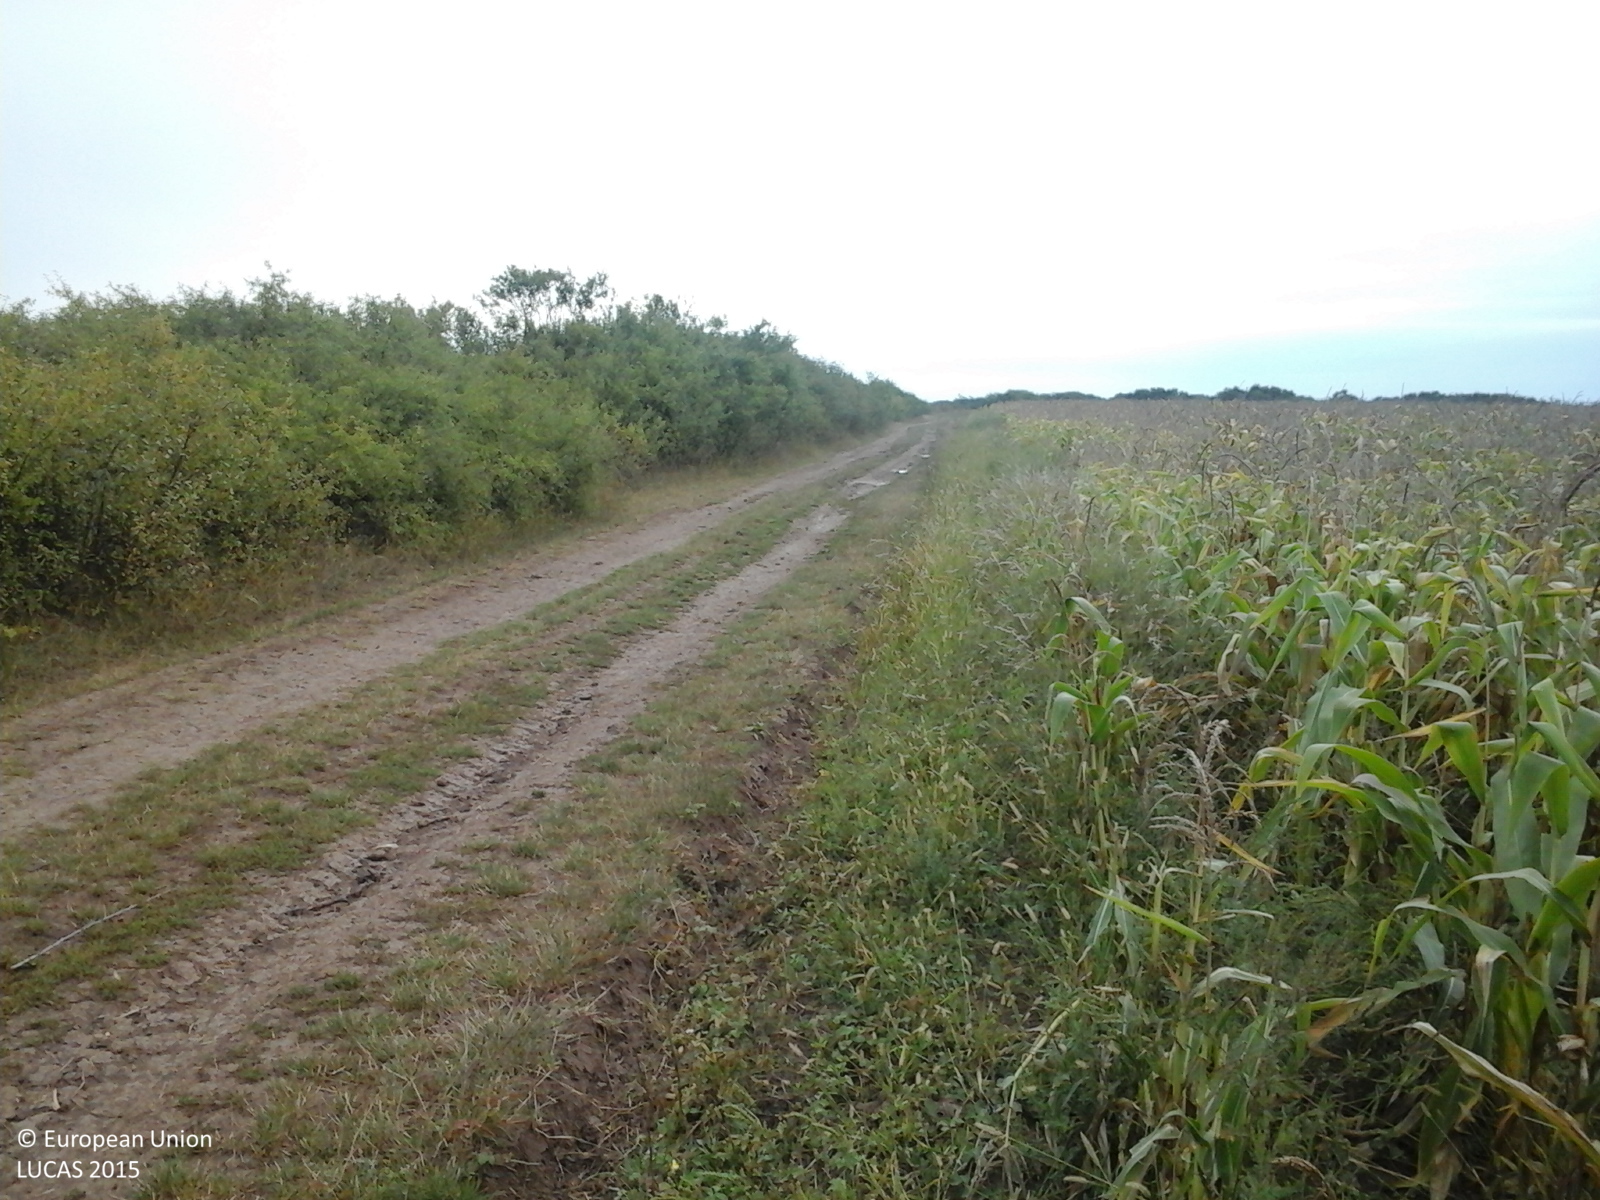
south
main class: Cropland
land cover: Maize
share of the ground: > 75 %
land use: Agriculture (excluding fallow land and kitchen gardens)
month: September
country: RO
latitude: 46.7552
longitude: 21.7594
